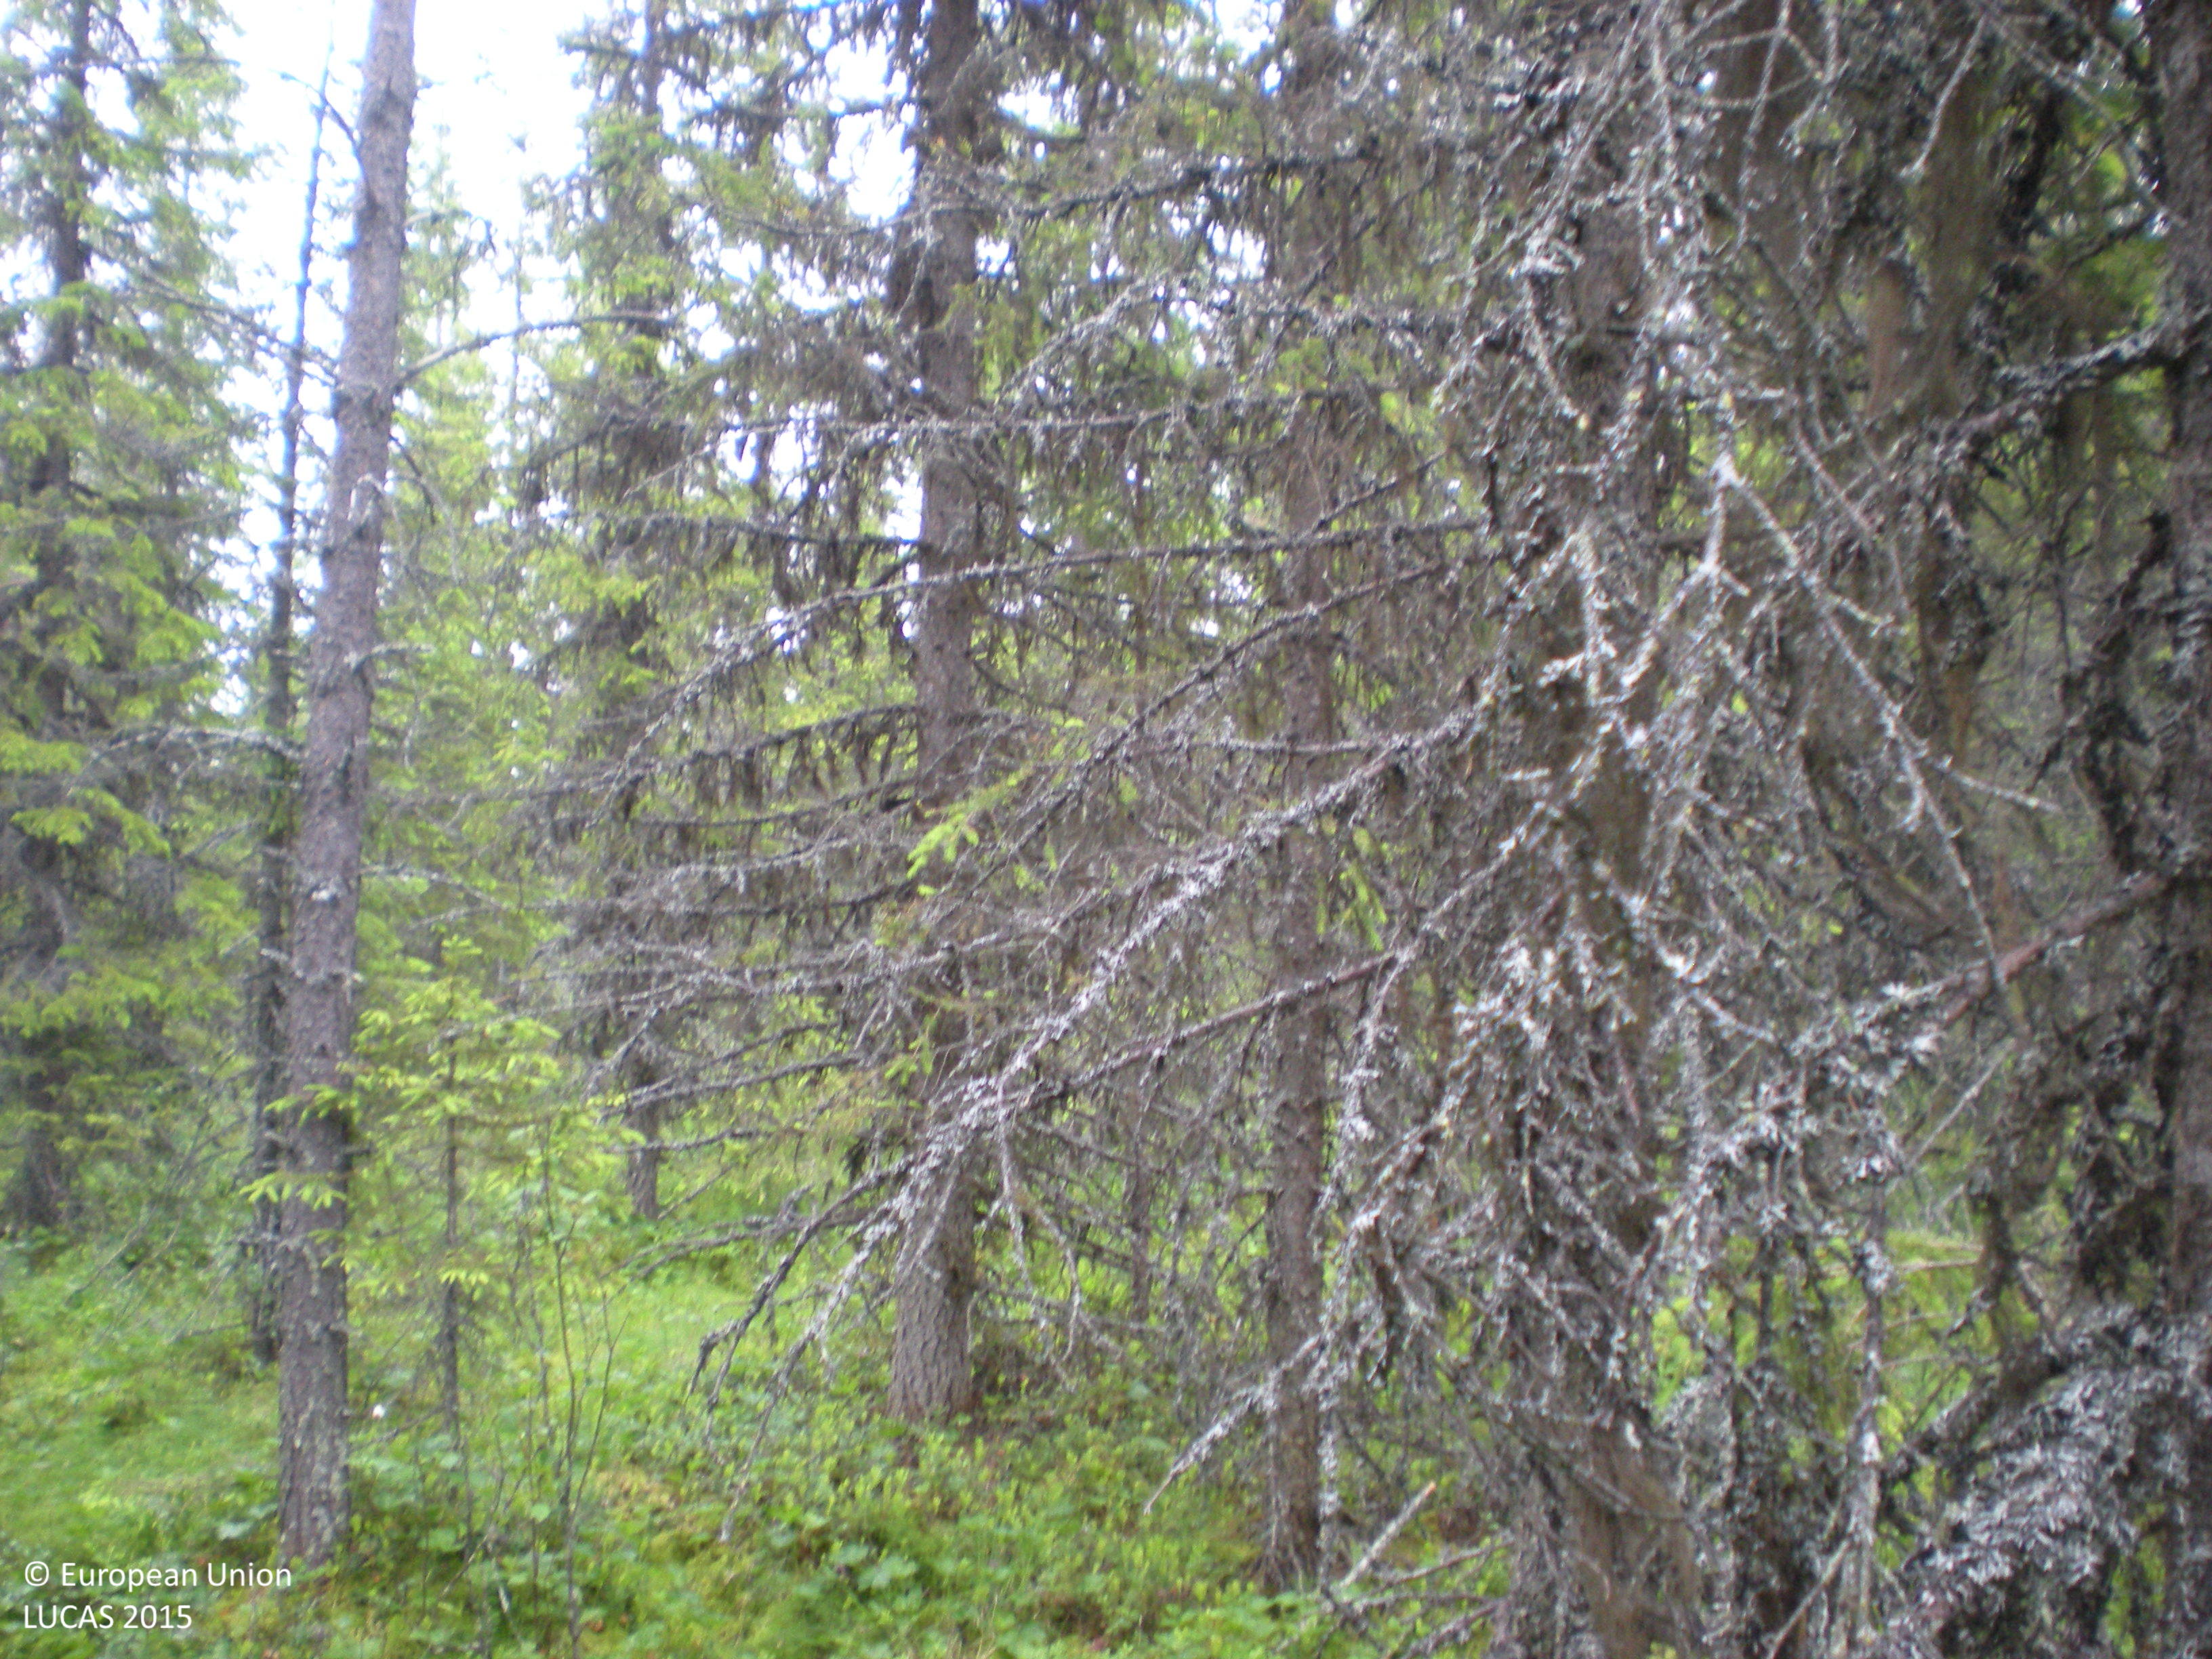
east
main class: Woodland
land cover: Spruce dominated coniferous woodland
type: boreal forest
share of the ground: > 75 %
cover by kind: coniferous forest trees 75 %, lichens and mosses 15 %, herbaceous plants 10 %
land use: Forestry
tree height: > 5 m
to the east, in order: Spruce dominated coniferous woodland; Broadleaved woodland; Rivers and streams; Spruce dominated mixed woodland; Spruce dominated coniferous woodland; Tracks; Other coniferous woodland; Other mixed woodland; Other coniferous woodland; Tracks; Other coniferous woodland
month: July
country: SE
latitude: 65.5237
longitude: 17.9845
